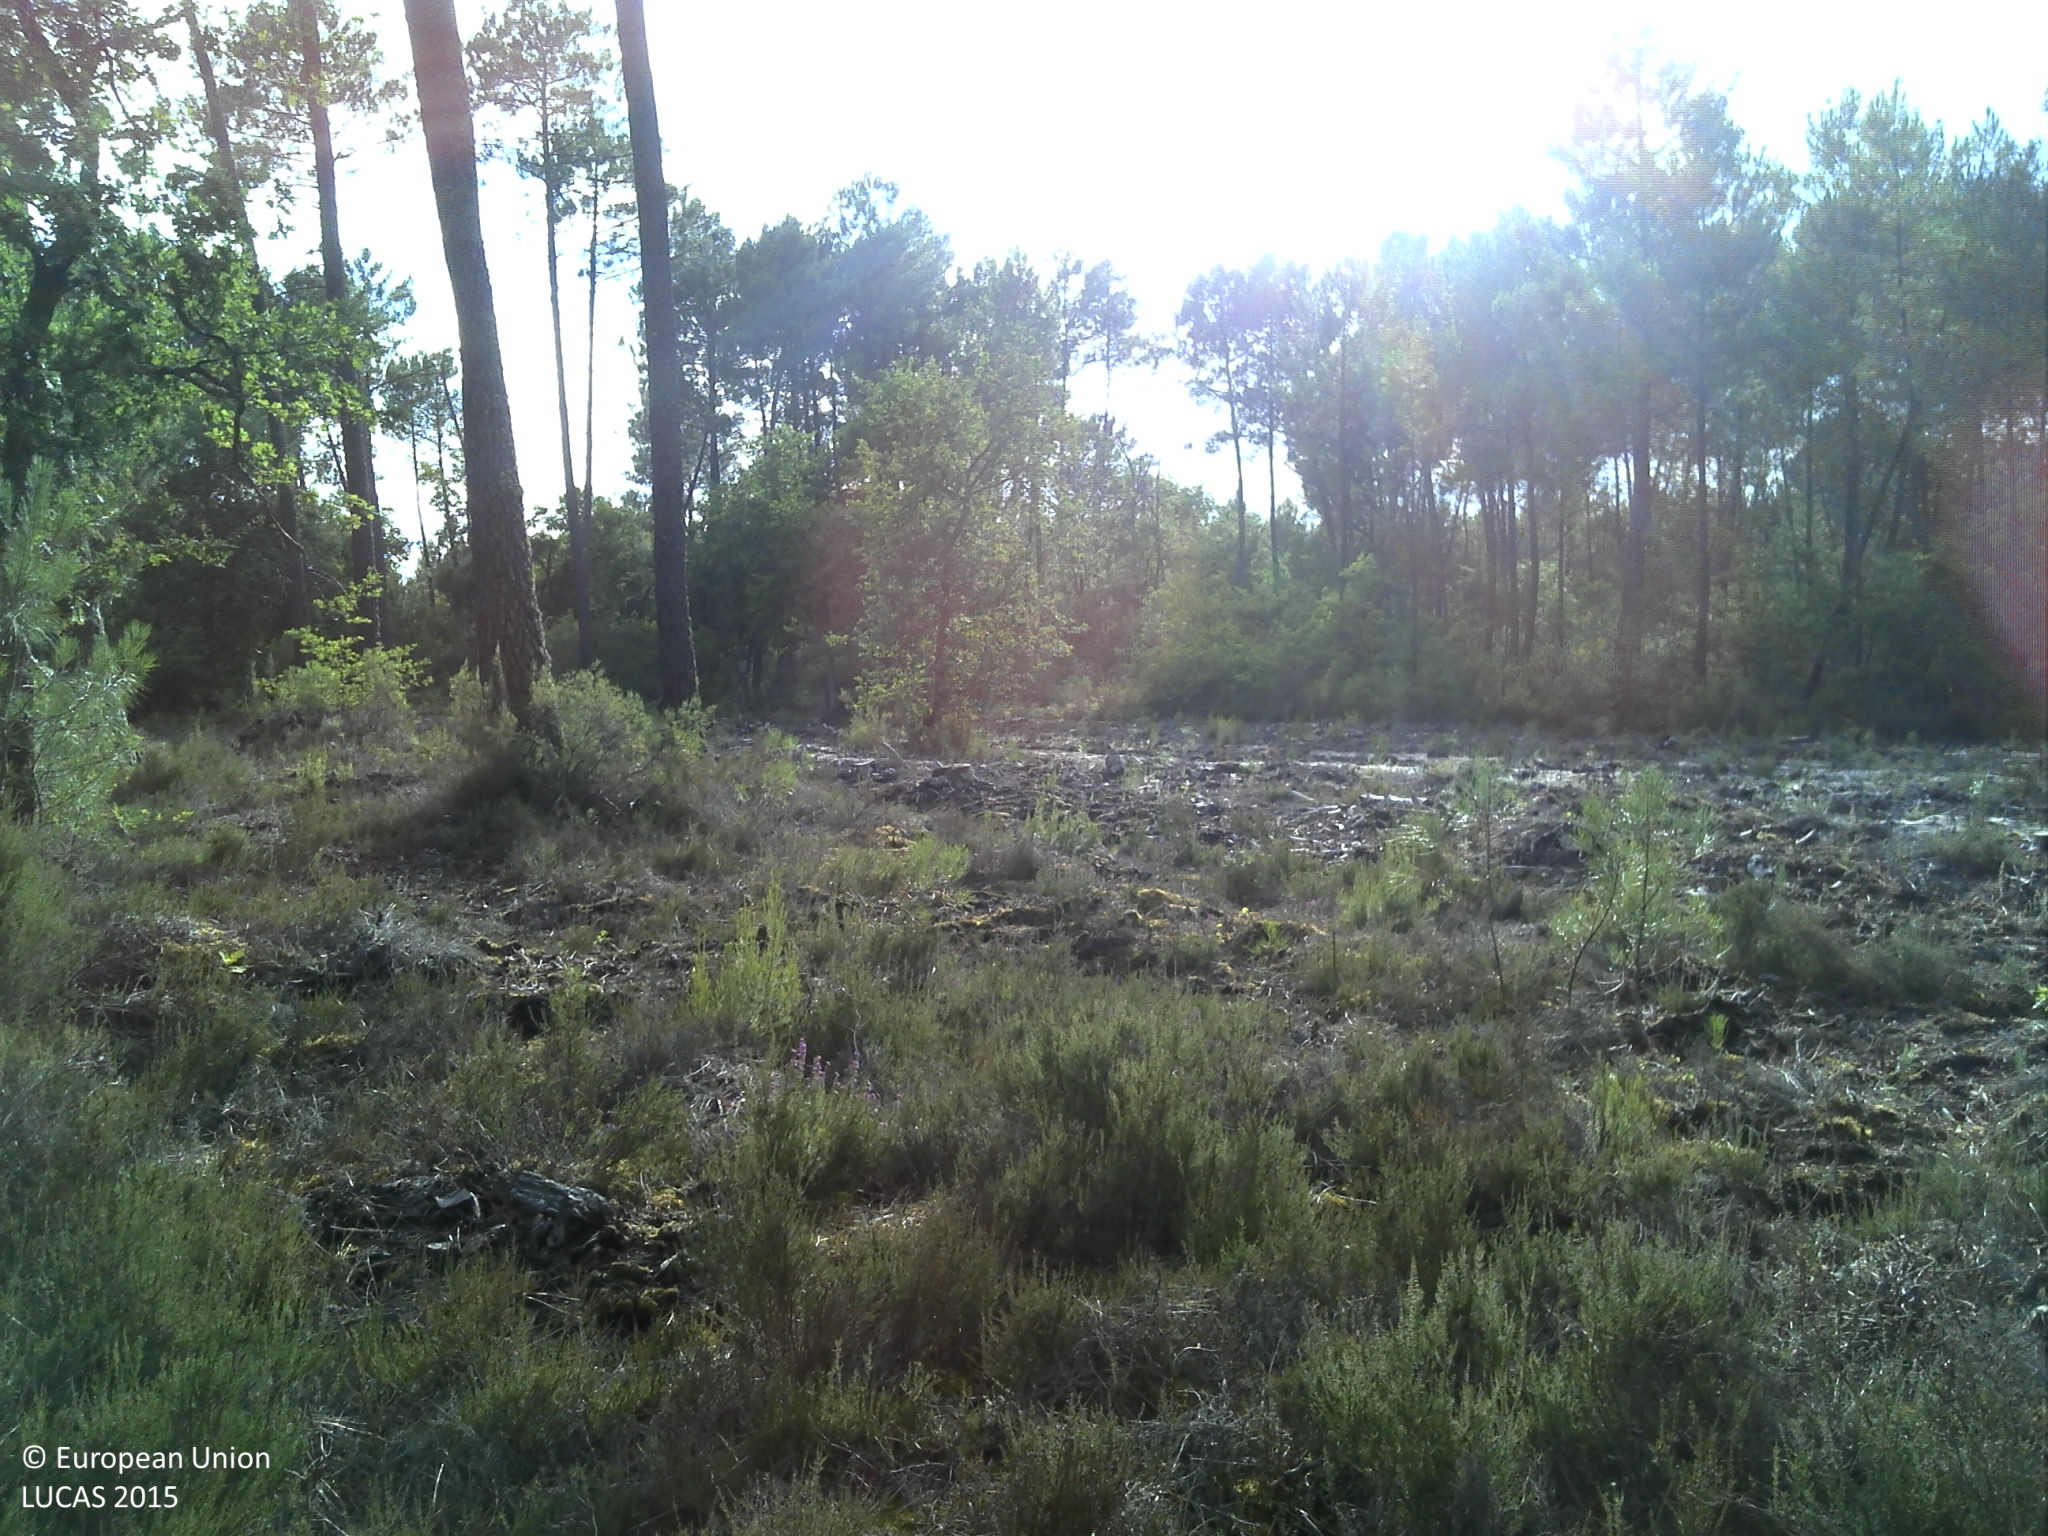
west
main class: Woodland
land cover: Pine dominated coniferous woodland
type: coniferous forest of the mediterranean region
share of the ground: 50 - 75 %
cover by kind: coniferous forest trees 60 %, shrubs 30 %, herbaceous plants 5 %, lichens and mosses 5 %
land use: Forestry
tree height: > 5 m
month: July
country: FR
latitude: 44.5021
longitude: -0.8990
